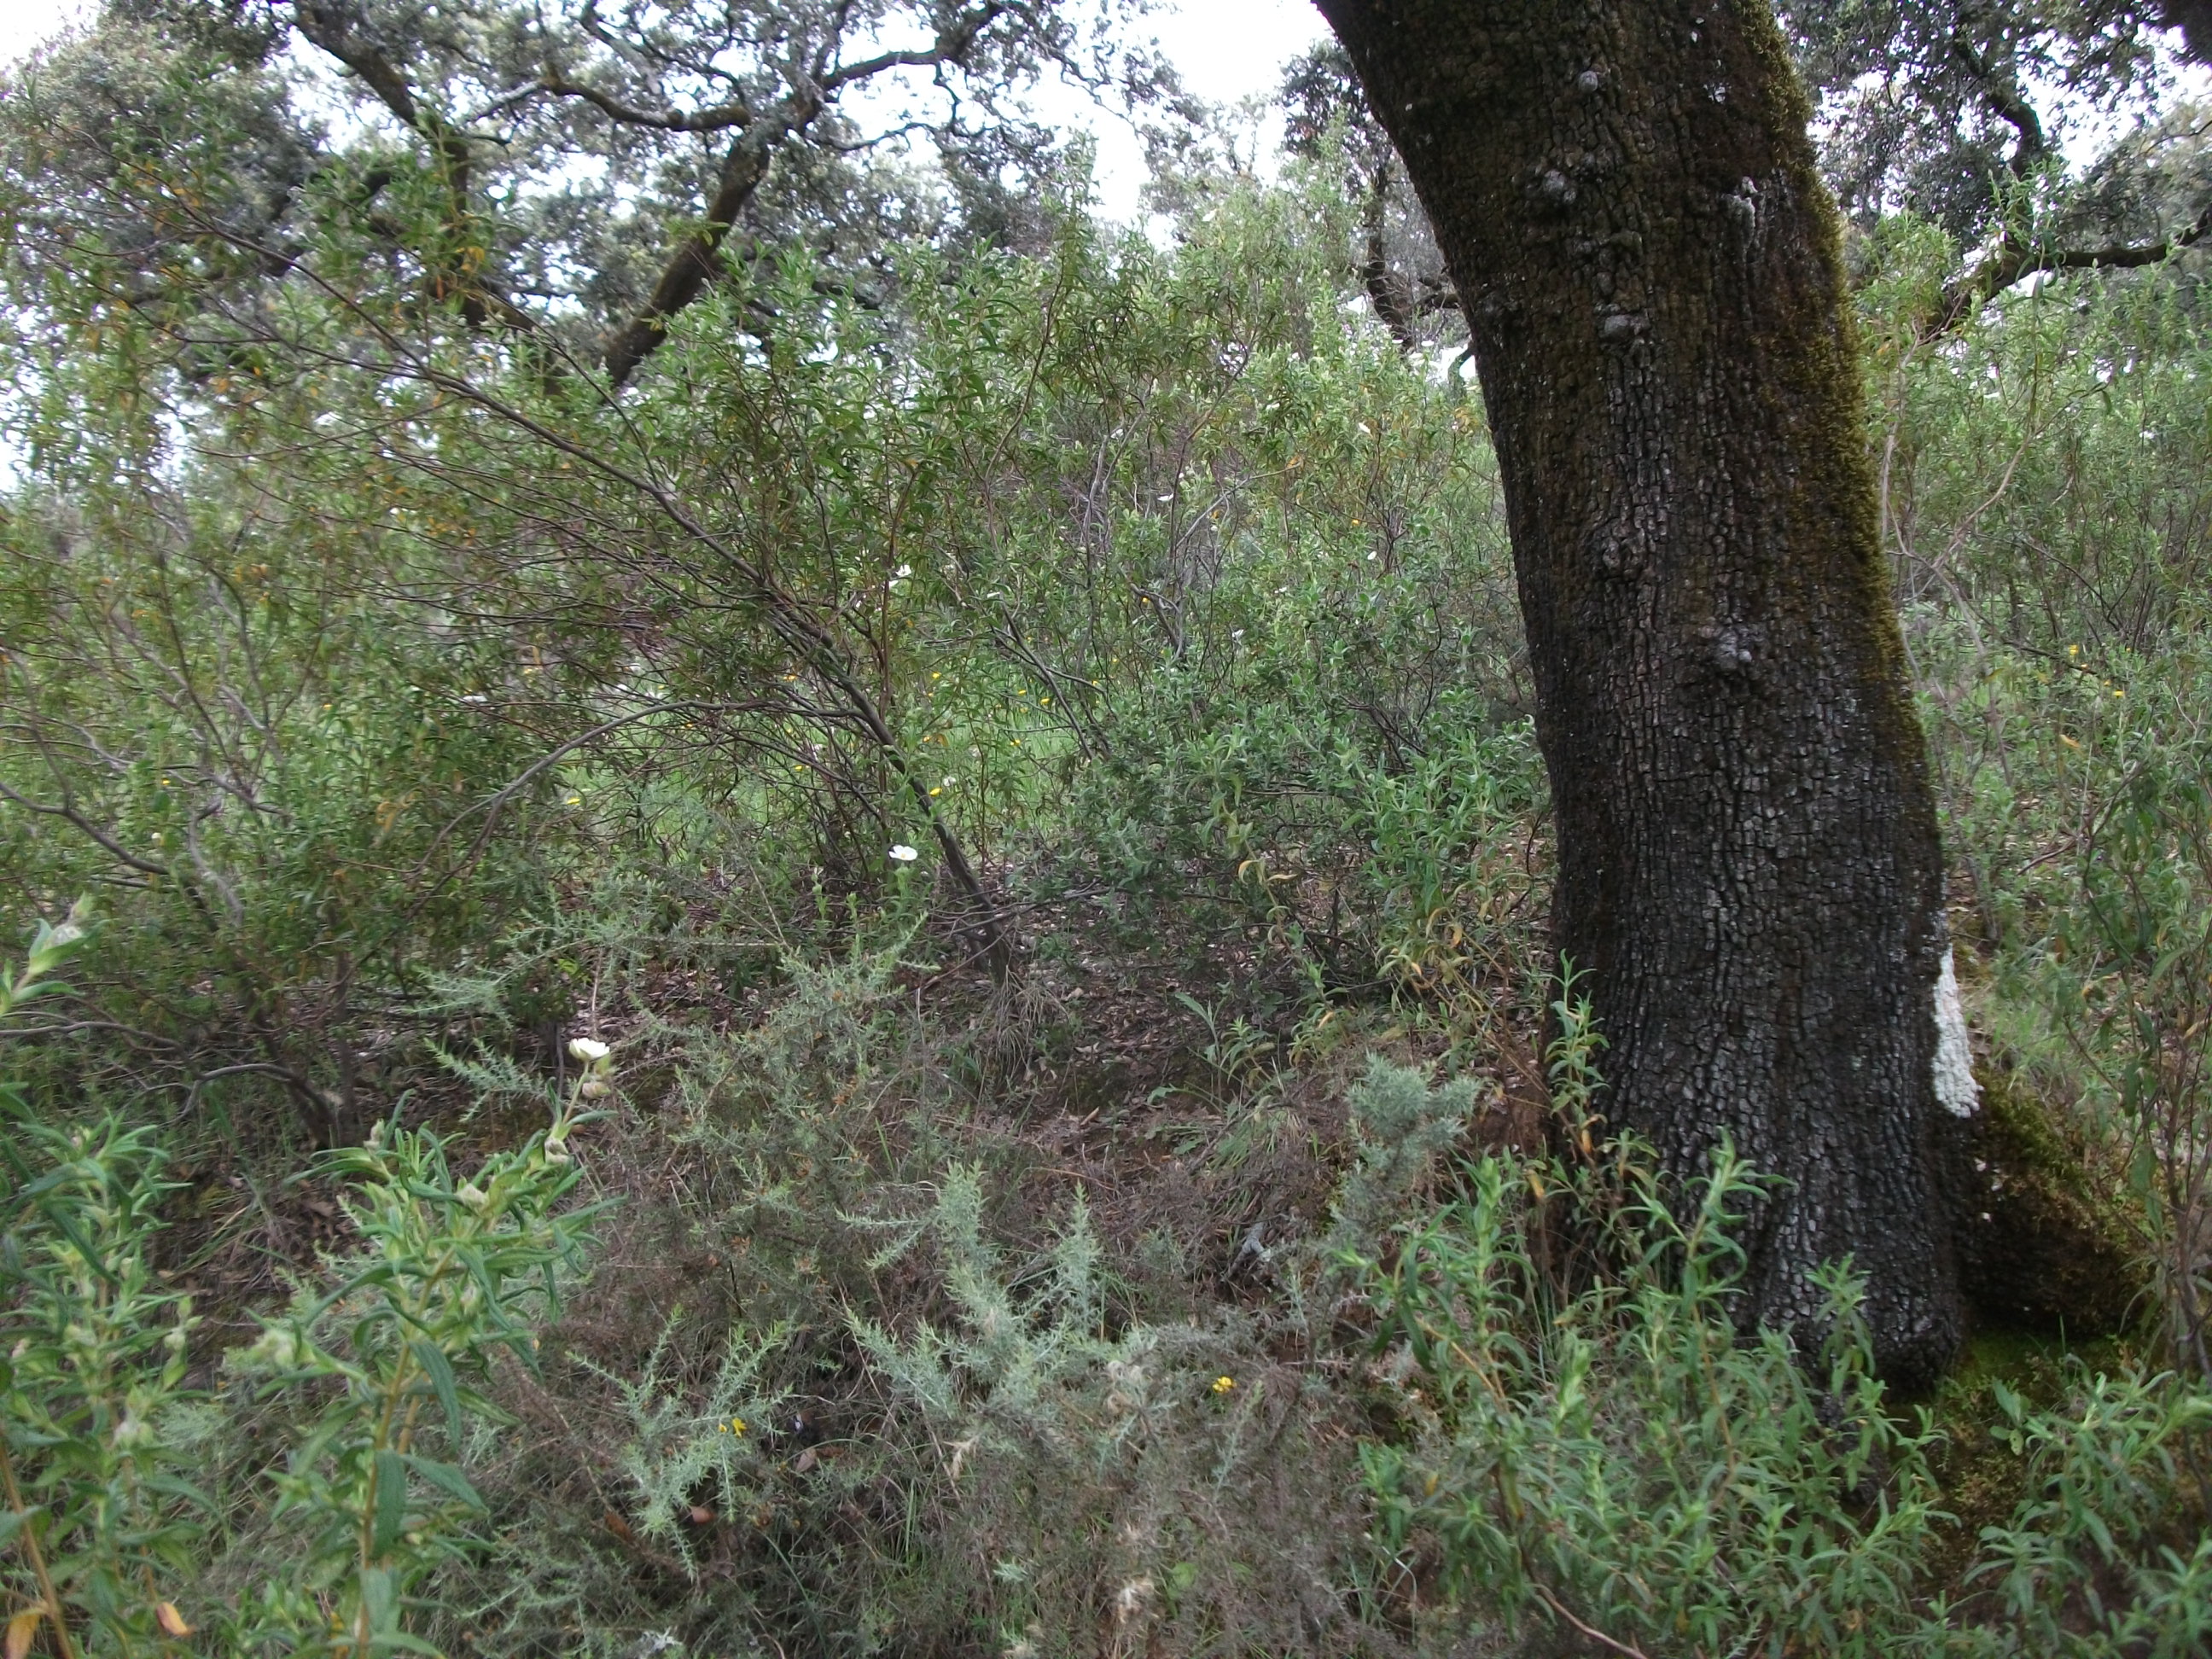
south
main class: Woodland
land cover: Broadleaved woodland
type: broadleaved evergreen forest
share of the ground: 25 - 50 %
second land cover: Shrubland without tree cover
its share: > 75 %
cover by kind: broadleaved forest trees 50 %, shrubs 45 %, herbaceous plants 5 %
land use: Forestry
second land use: Agriculture (excluding fallow land and kitchen gardens)
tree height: > 5 m
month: April
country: ES
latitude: 37.8403
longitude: -6.7384
